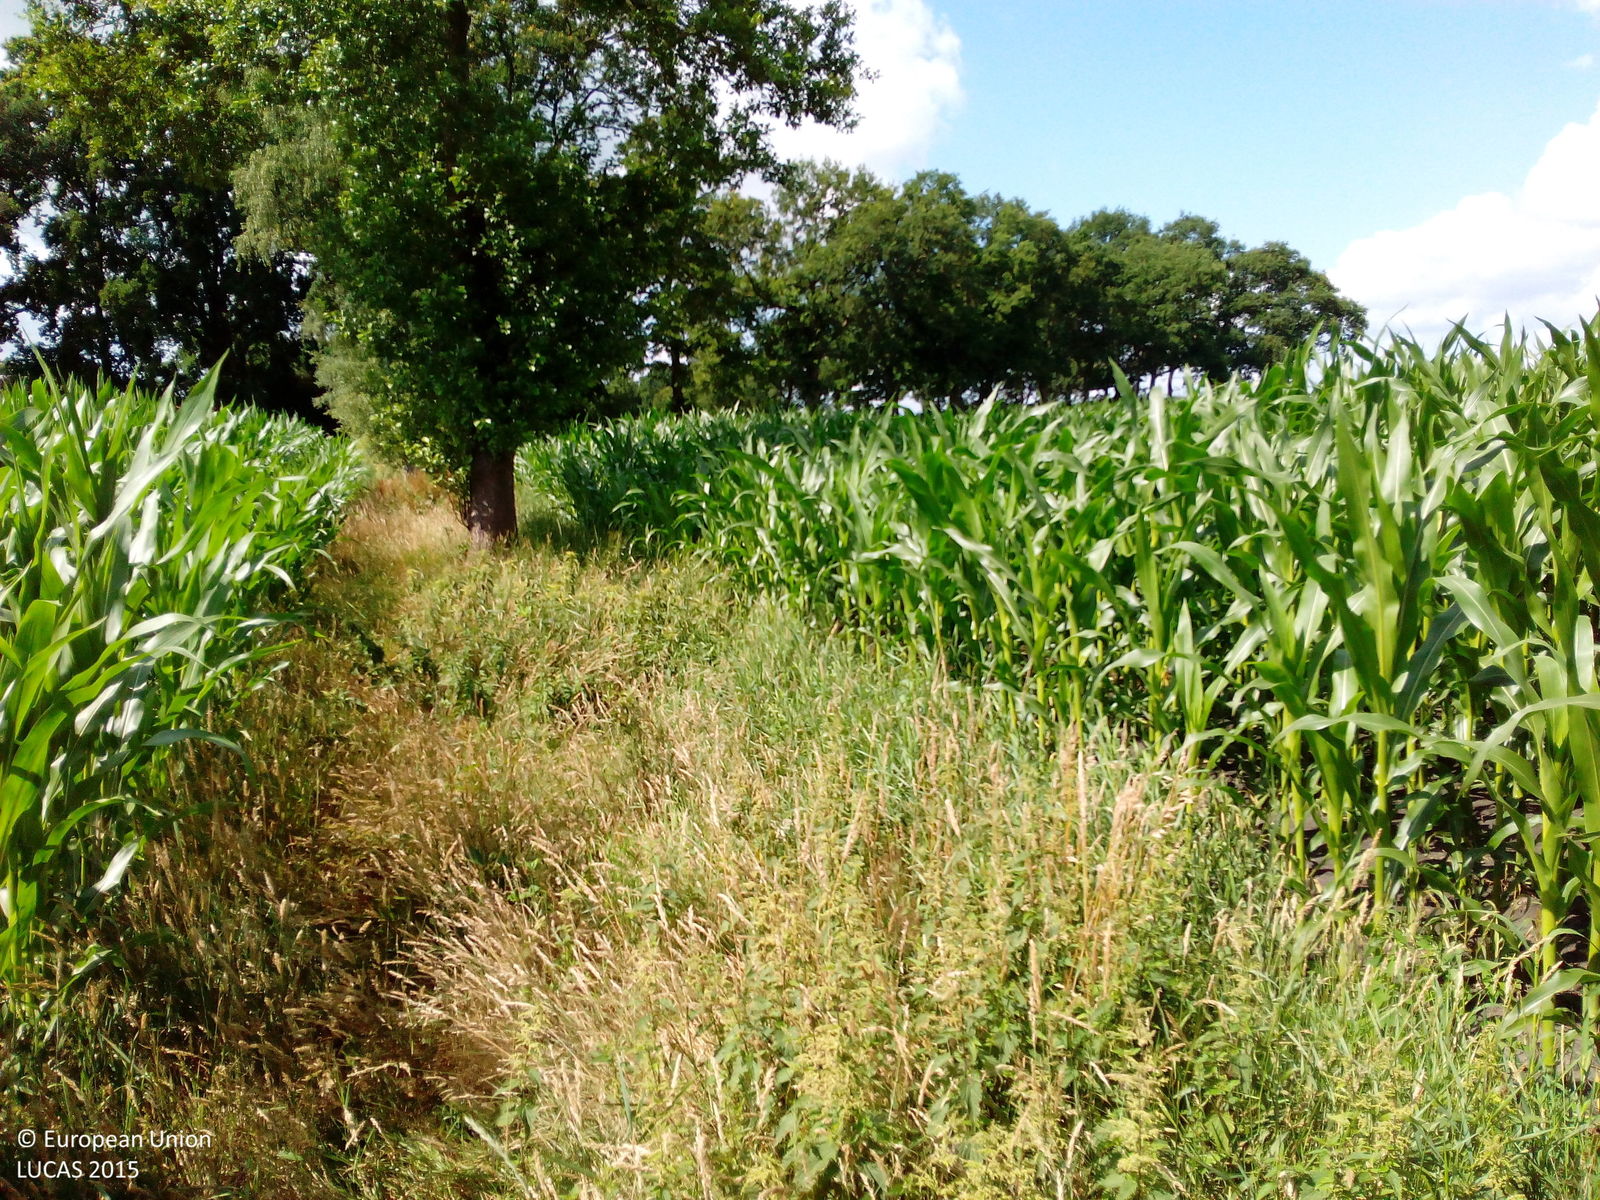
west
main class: Cropland
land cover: Maize
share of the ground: > 75 %
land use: Agriculture (excluding fallow land and kitchen gardens)
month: July
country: DE
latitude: 53.1324
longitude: 7.9231
